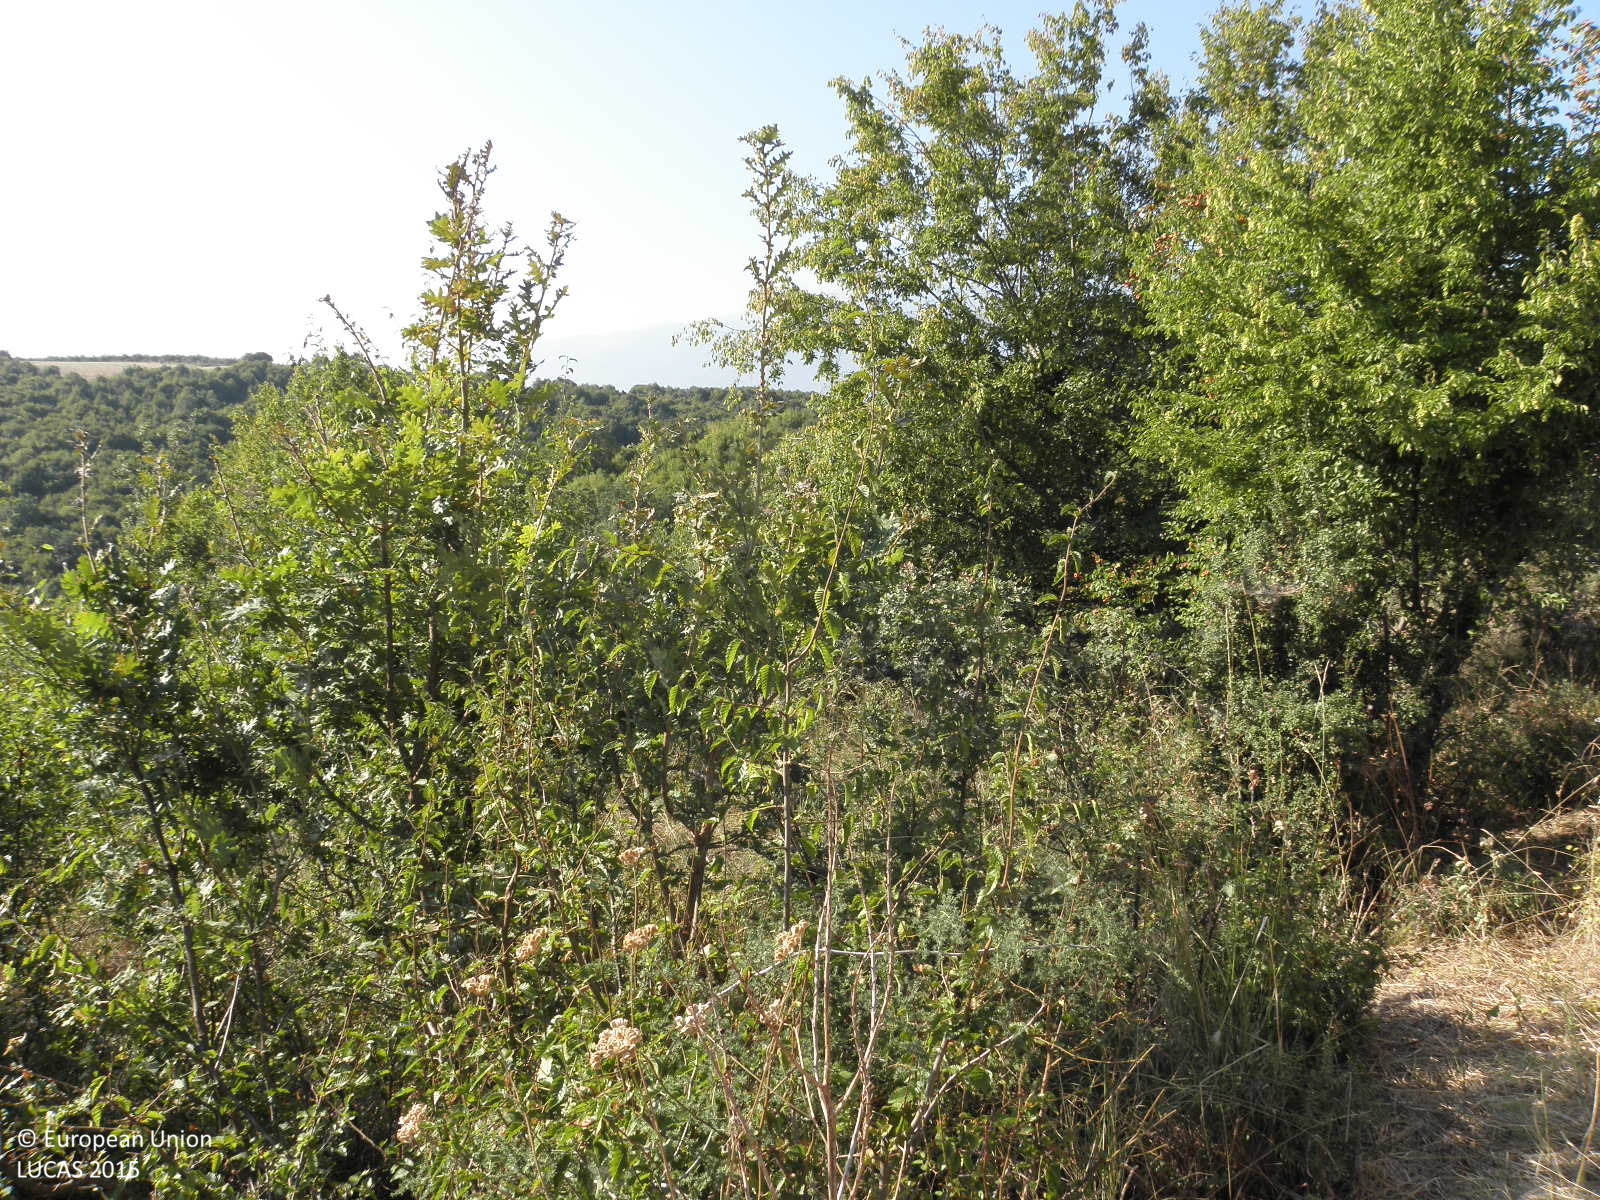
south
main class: Woodland
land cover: Broadleaved woodland
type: thermophilous deciduous forest
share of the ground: 50 - 75 %
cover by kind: broadleaved forest trees 60 %, shrubs 30 %, herbaceous plants 10 %
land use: Semi-natural and natural areas not in use
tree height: > 5 m
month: September
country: GR
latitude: 40.2394
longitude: 22.4451
